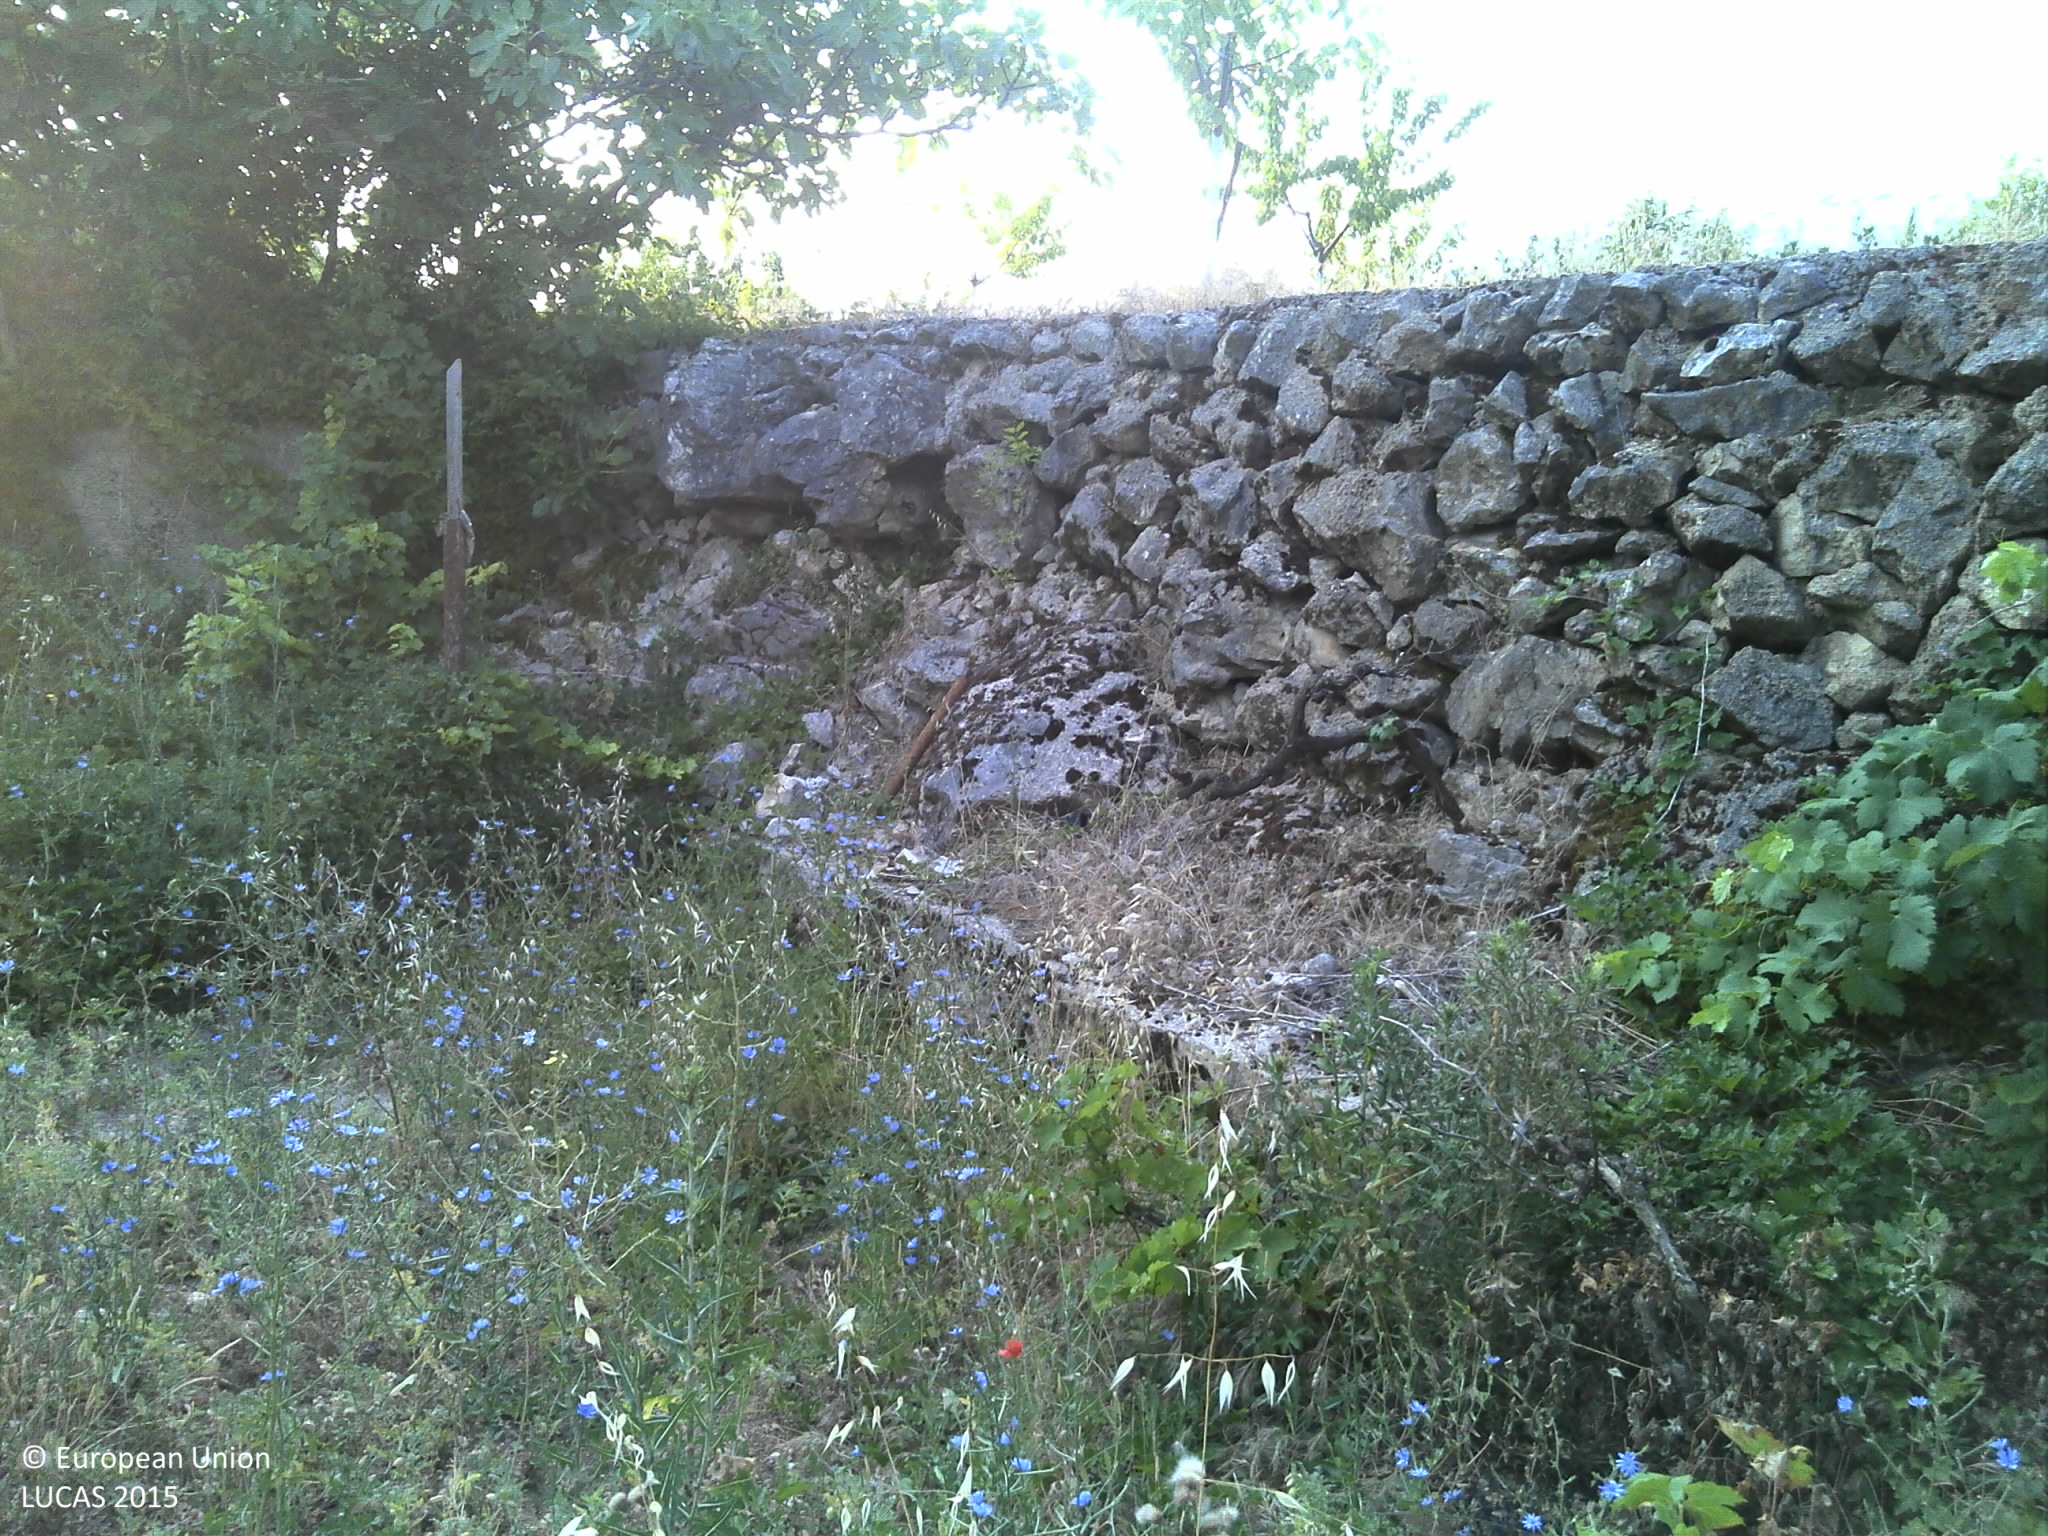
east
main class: Grassland
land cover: Grassland without tree/shrub cover
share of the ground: > 75 %
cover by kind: herbaceous plants 90 %, shrubs 5 %, consolidated bare surface 5 %
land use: Agriculture (excluding fallow land and kitchen gardens)
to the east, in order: Grassland without tree/shrub cover; Dry stone walls; Grassland without tree/shrub cover; Rock outcrops; Tracks; Rock outcrops; Other mixed woodland; Paved roads, cycling and walking lanes; Other mixed woodland; Dry stone walls; Other mixed woodland
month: July
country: HR
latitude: 43.4331
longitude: 16.8970
